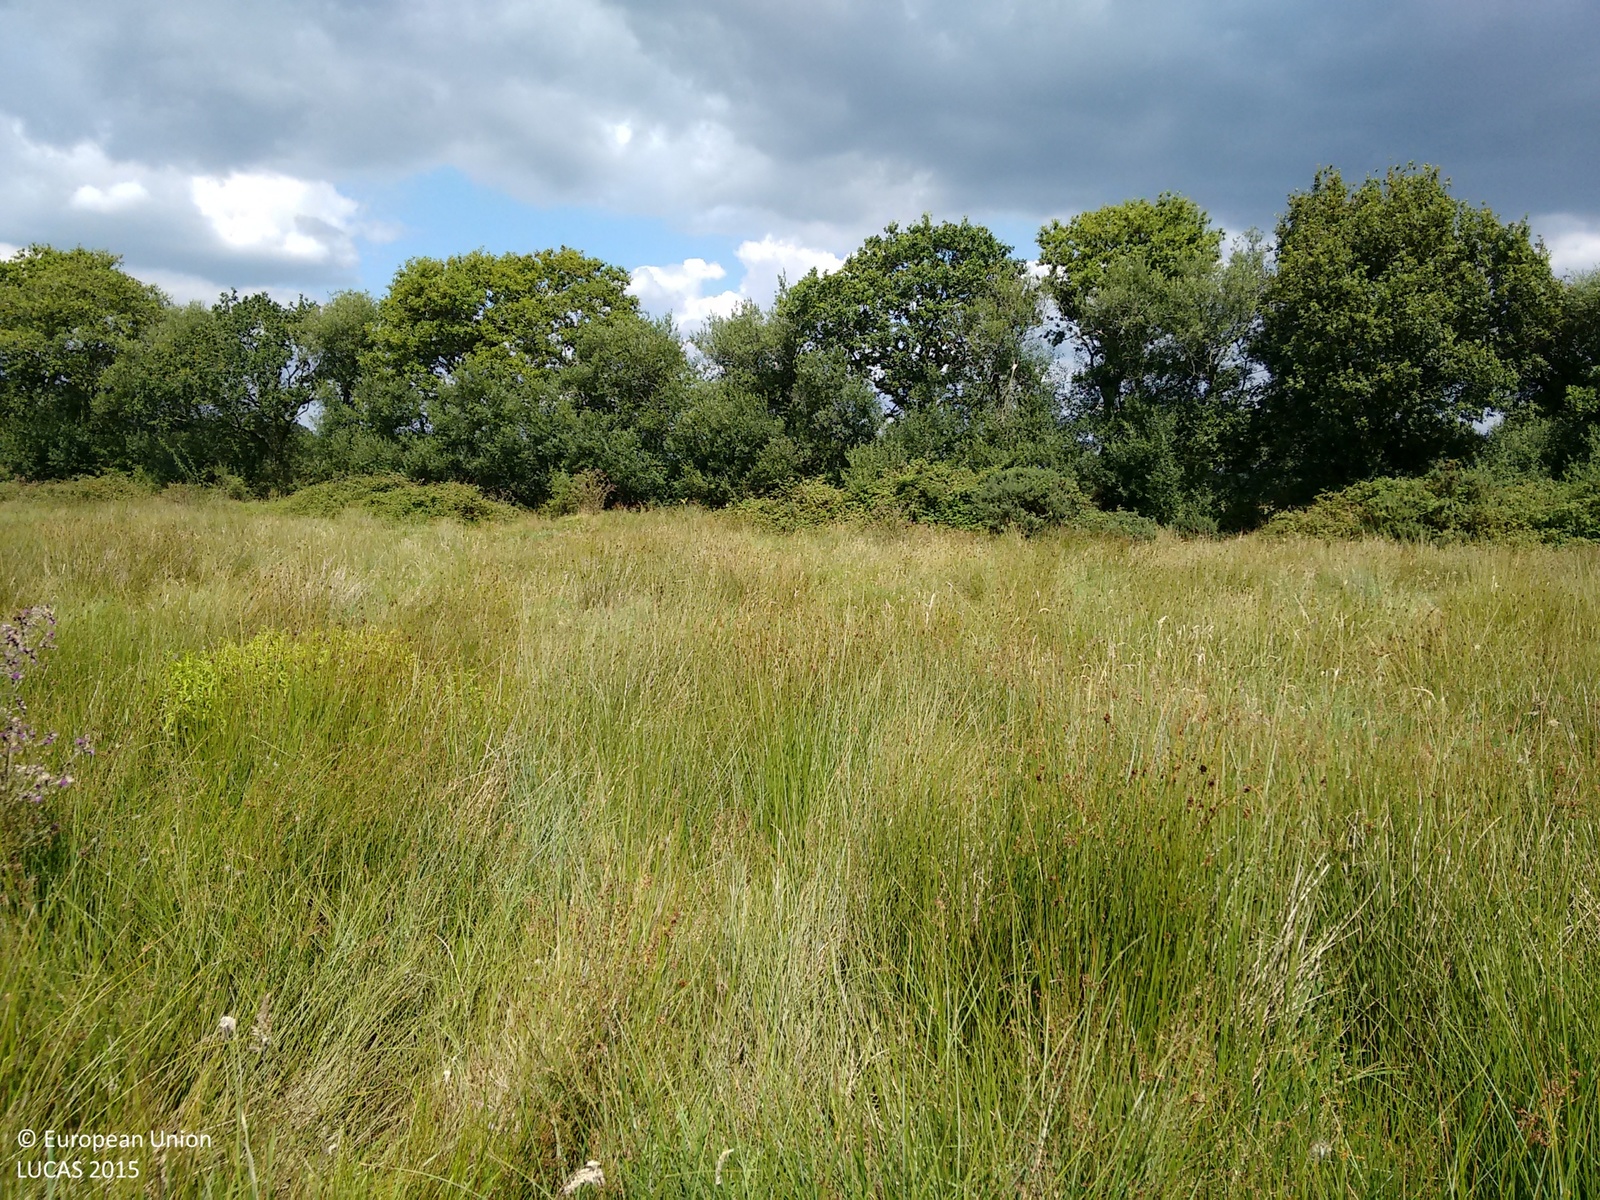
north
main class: Grassland
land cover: Grassland without tree/shrub cover
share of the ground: > 75 %
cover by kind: herbaceous plants 100 %
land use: Agriculture (excluding fallow land and kitchen gardens)
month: August
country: GB
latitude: 51.8158
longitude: -4.4510
